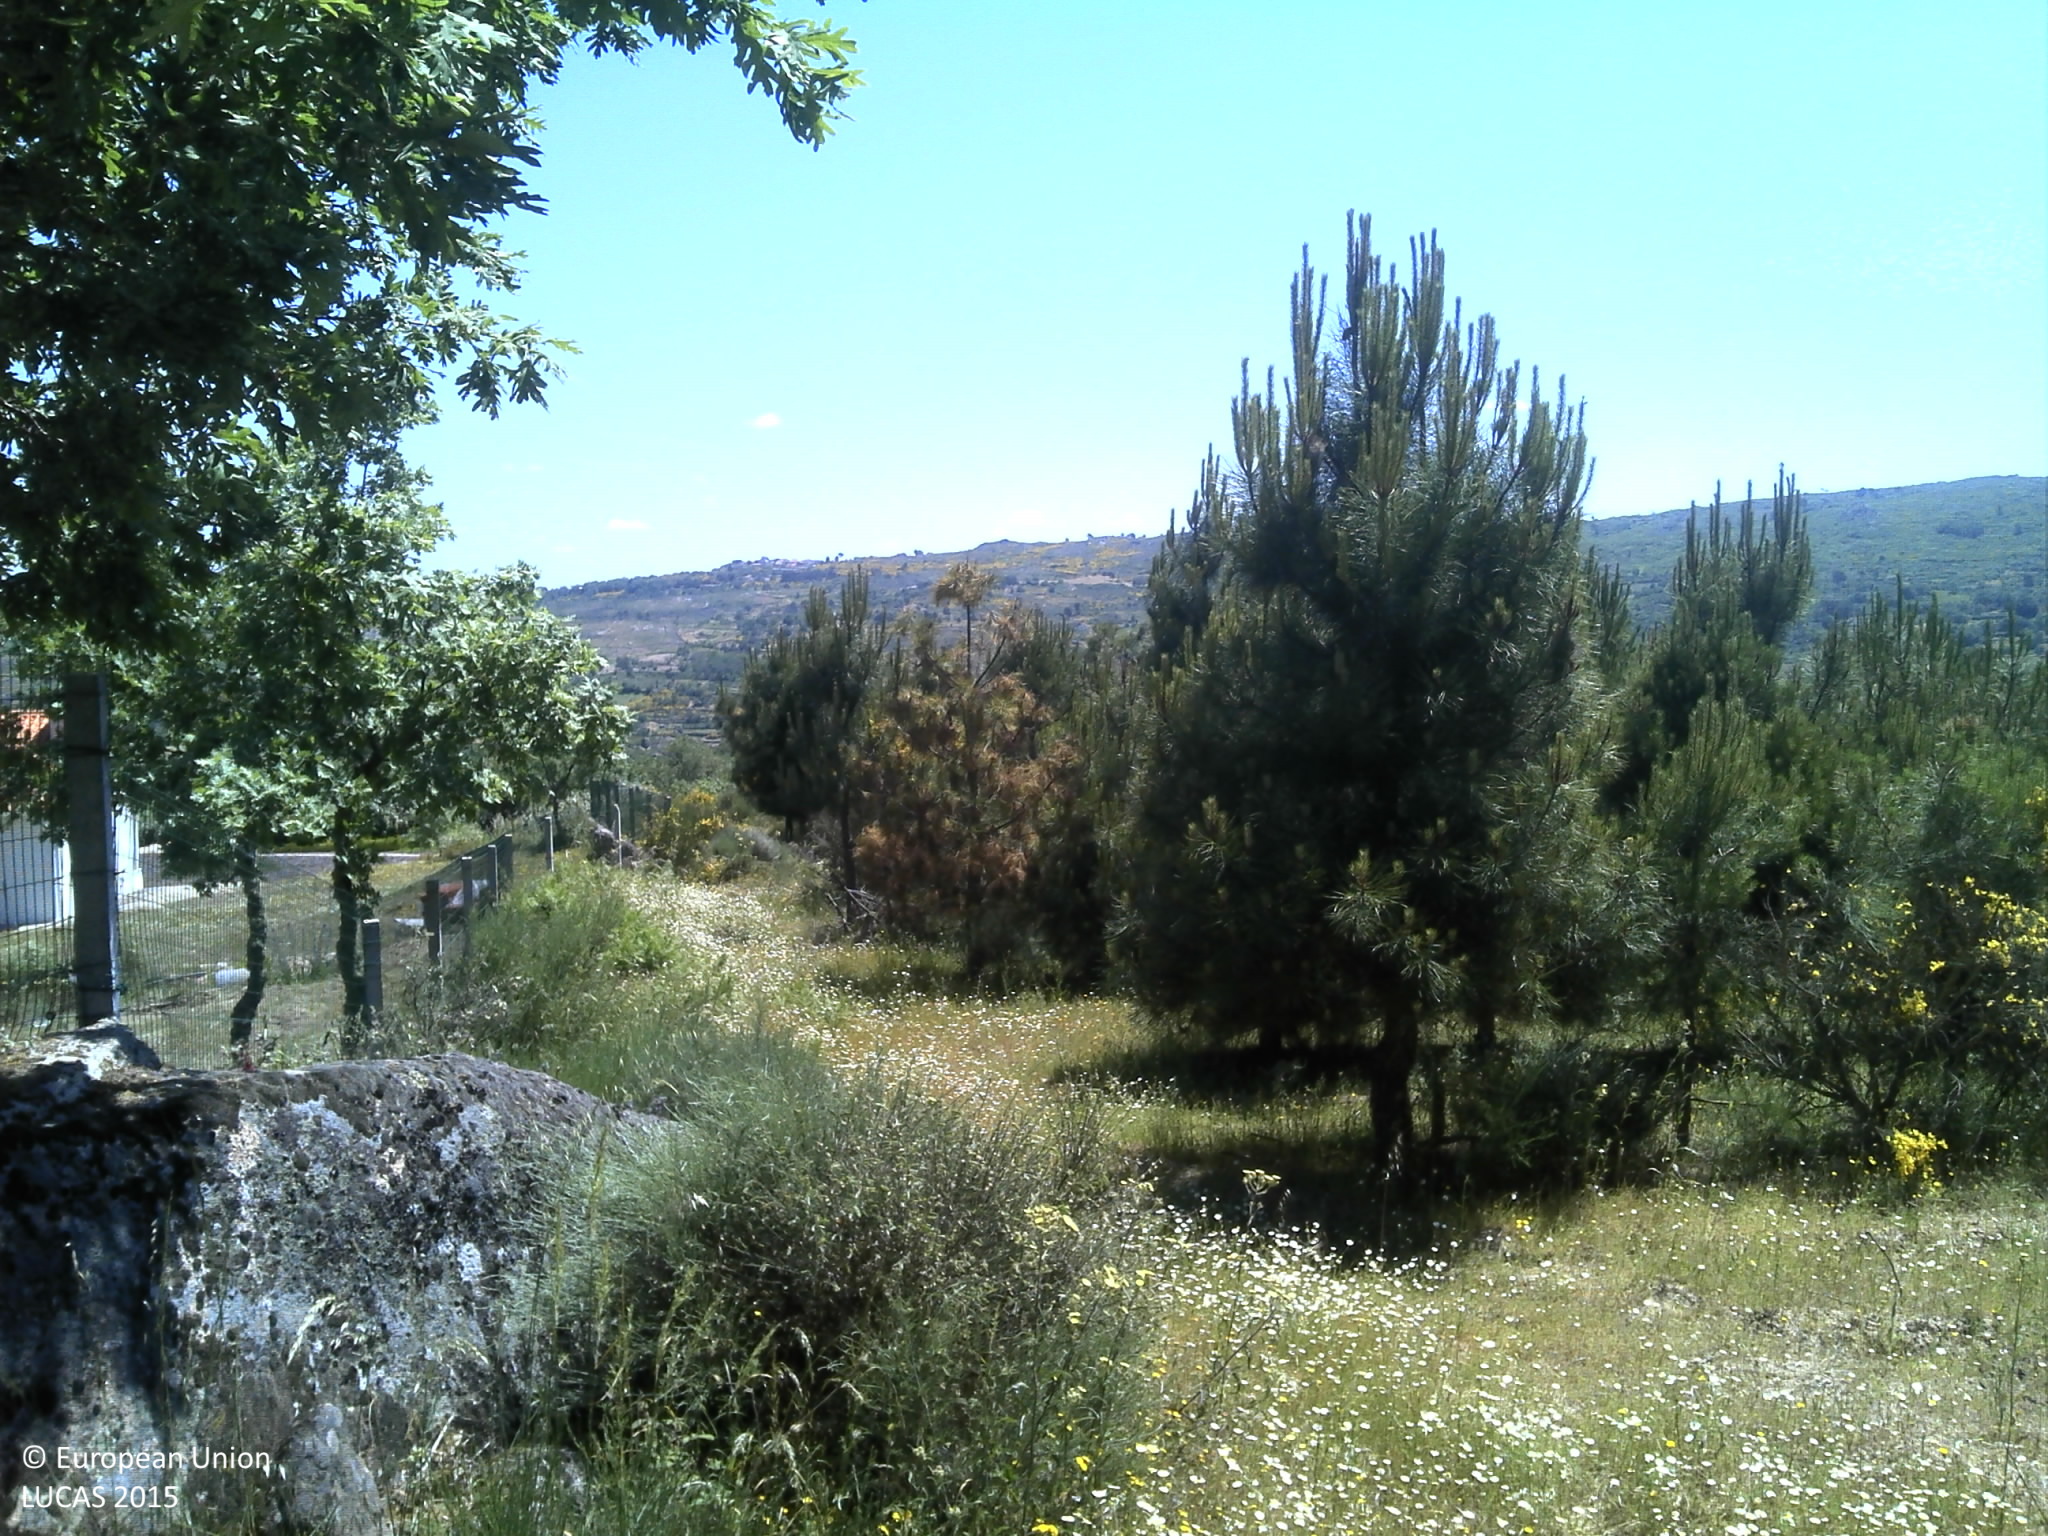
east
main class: Grassland
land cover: Grassland without tree/shrub cover
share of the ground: 25 - 50 %
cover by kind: herbaceous plants 50 %, consolidated bare surface 40 %
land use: Agriculture (excluding fallow land and kitchen gardens)
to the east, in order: Grassland without tree/shrub cover; Fences; Grass margins; Pine dominated coniferous woodland; Grass margins; Paved roads, cycling and walking lanes; Grass margins; Shrubland without tree cover; Maize; Spontaneously vegetated surfaces; Single bushes/trees; Spontaneously vegetated surfaces; Fences; Olive groves; Artificial constructions in urban areas; Olive groves
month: May
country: PT
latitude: 40.6461
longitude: -7.2421
